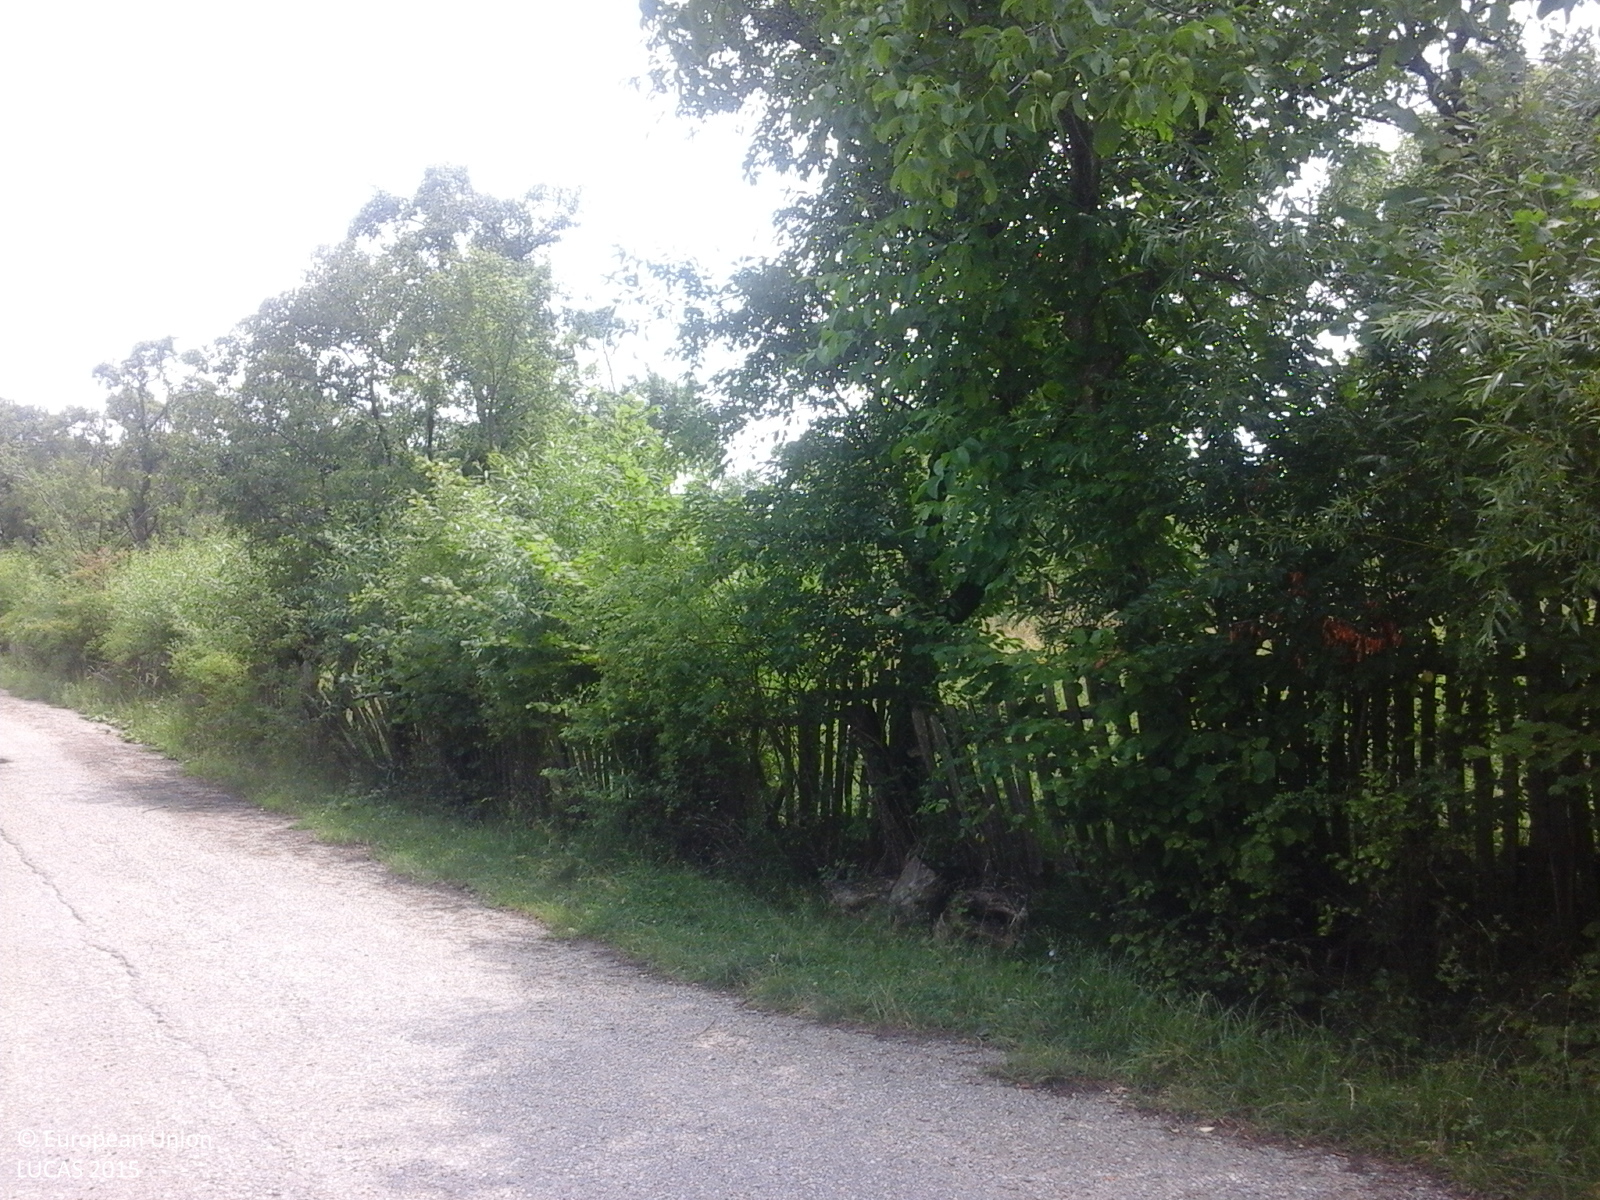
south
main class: Cropland
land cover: Other fruit trees and berries
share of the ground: 50 - 75 %
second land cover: Grassland without tree/shrub cover
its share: 50 - 75 %
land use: Agriculture (excluding fallow land and kitchen gardens)
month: July
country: RO
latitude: 45.3369
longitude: 24.7714
